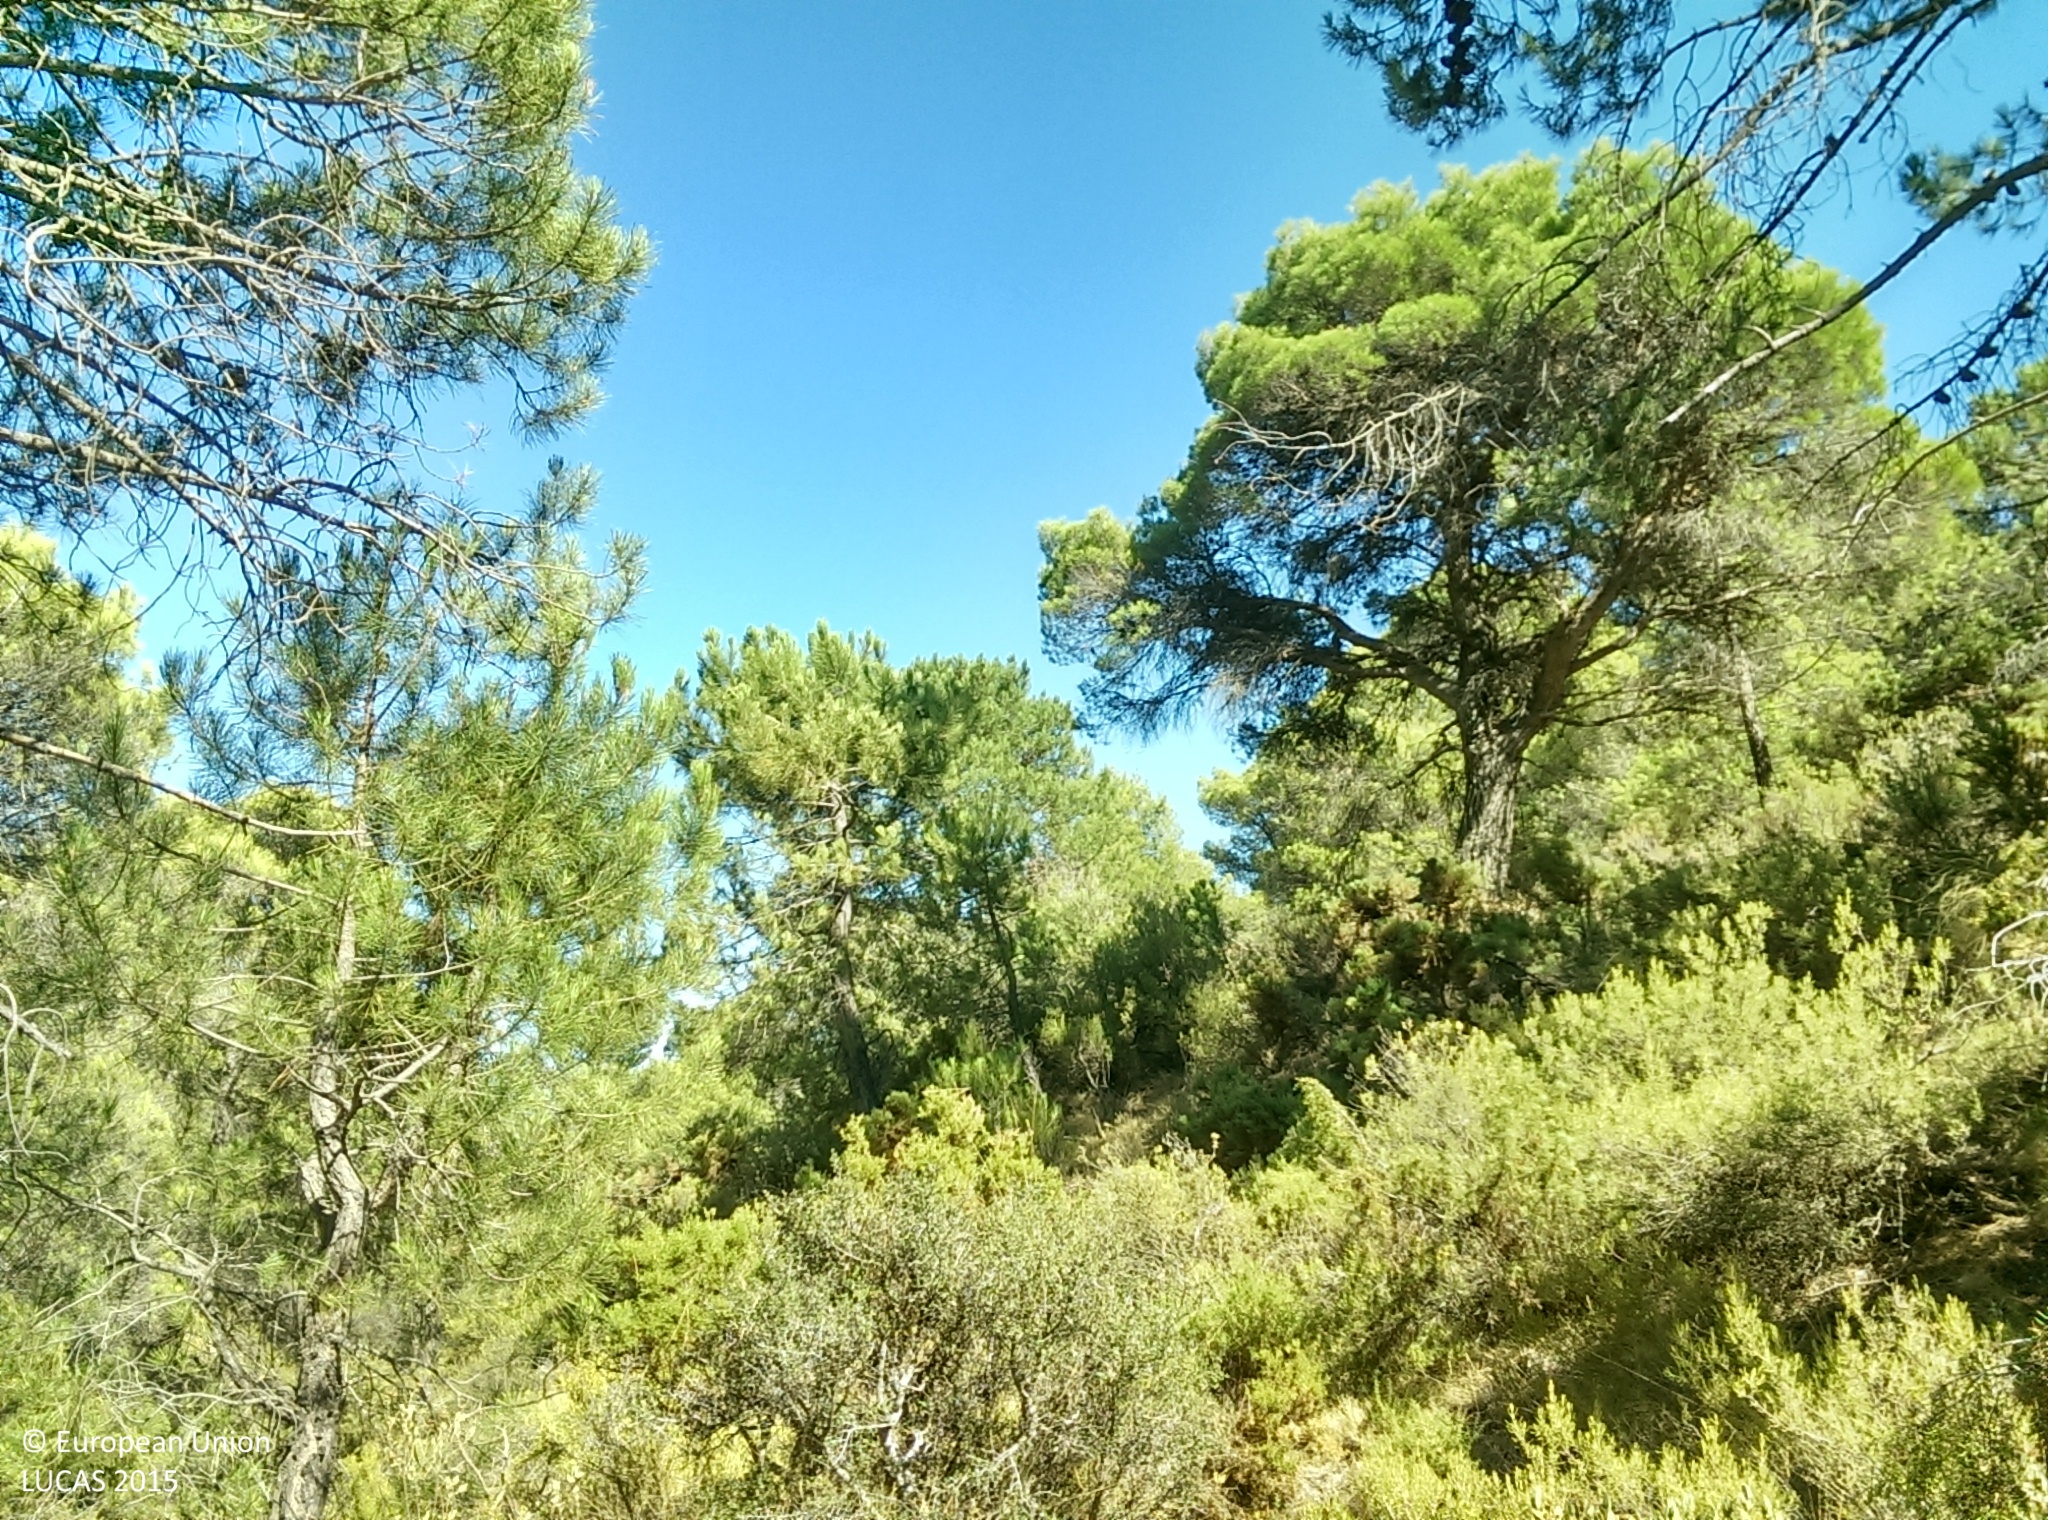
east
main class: Woodland
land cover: Pine dominated coniferous woodland
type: coniferous forest of the mediterranean region
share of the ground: 50 - 75 %
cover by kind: coniferous forest trees 65 %, shrubs 20 %, herbaceous plants 10 %, unconsolidated bare surface 5 %
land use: Forestry
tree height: > 5 m
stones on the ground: > 50 %
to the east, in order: Pine dominated coniferous woodland; Rivers and streams; Pine dominated coniferous woodland
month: August
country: ES
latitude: 36.8946
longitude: -3.5963
